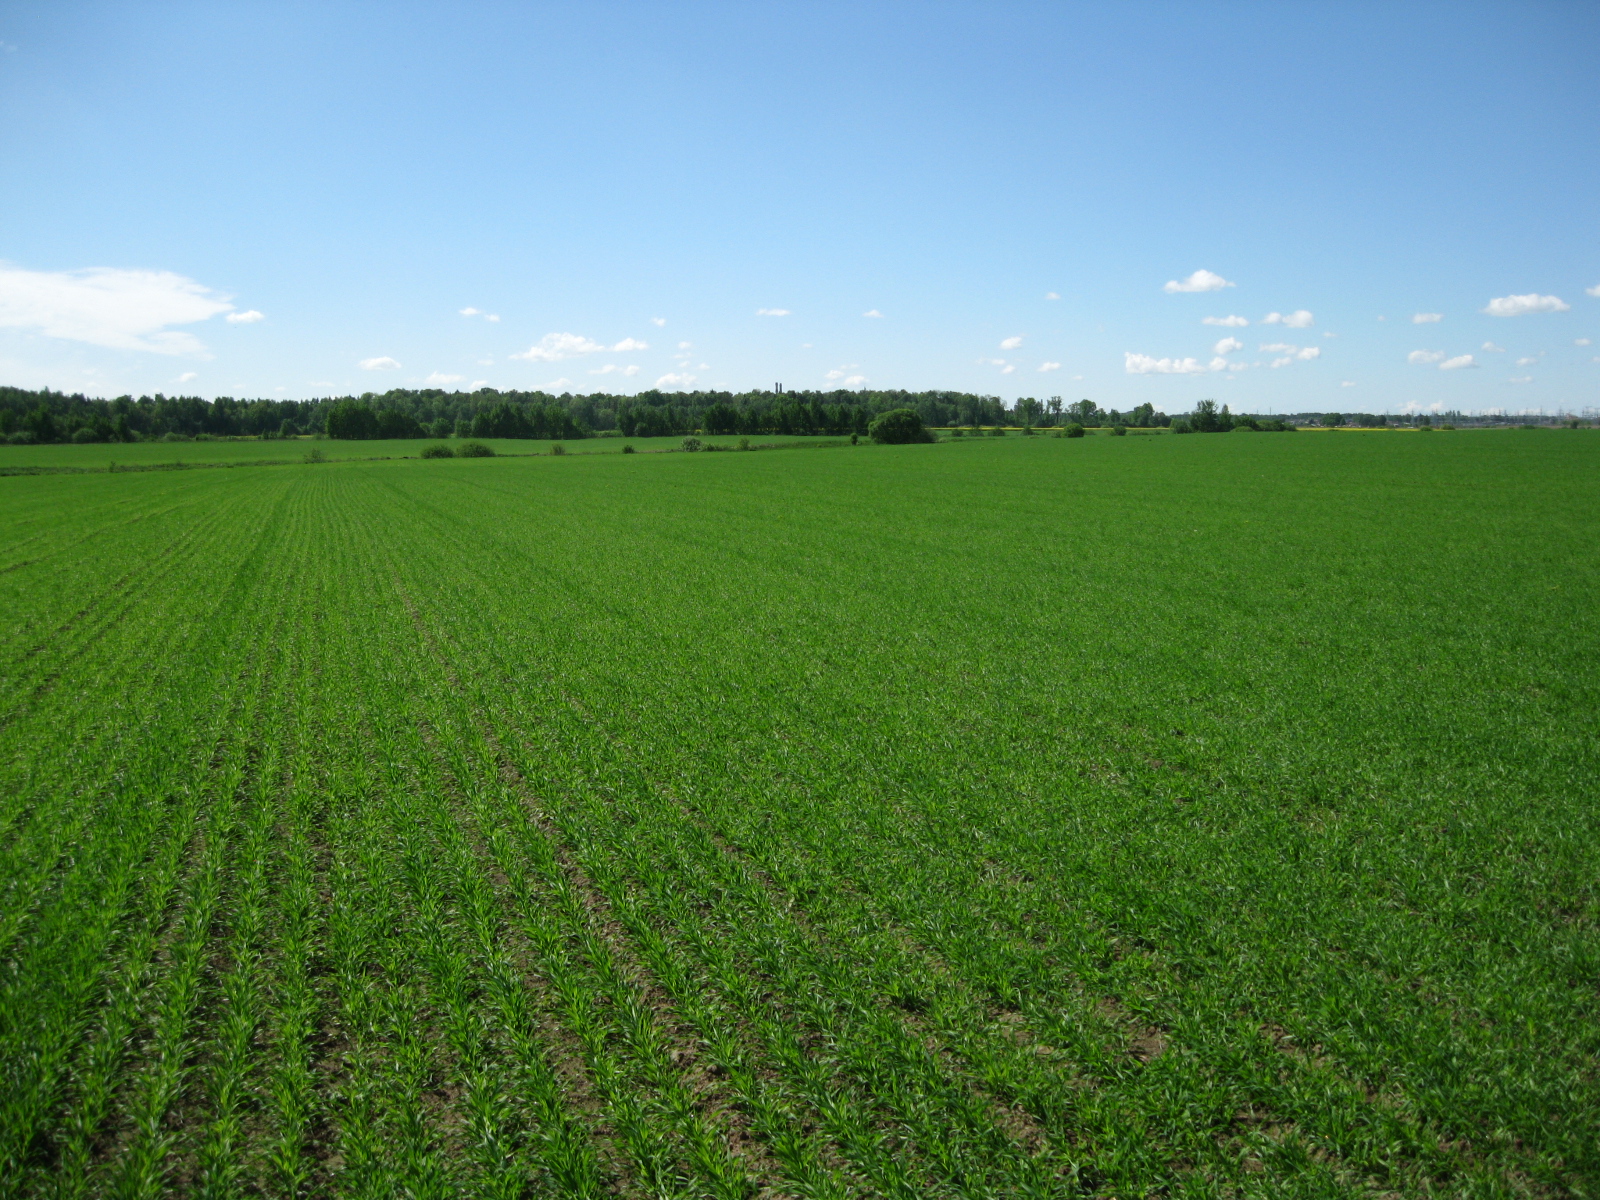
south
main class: Cropland
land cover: Barley
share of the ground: 50 - 75 %
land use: Agriculture (excluding fallow land and kitchen gardens)
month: May
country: LT
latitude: 55.7797
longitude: 24.3333
